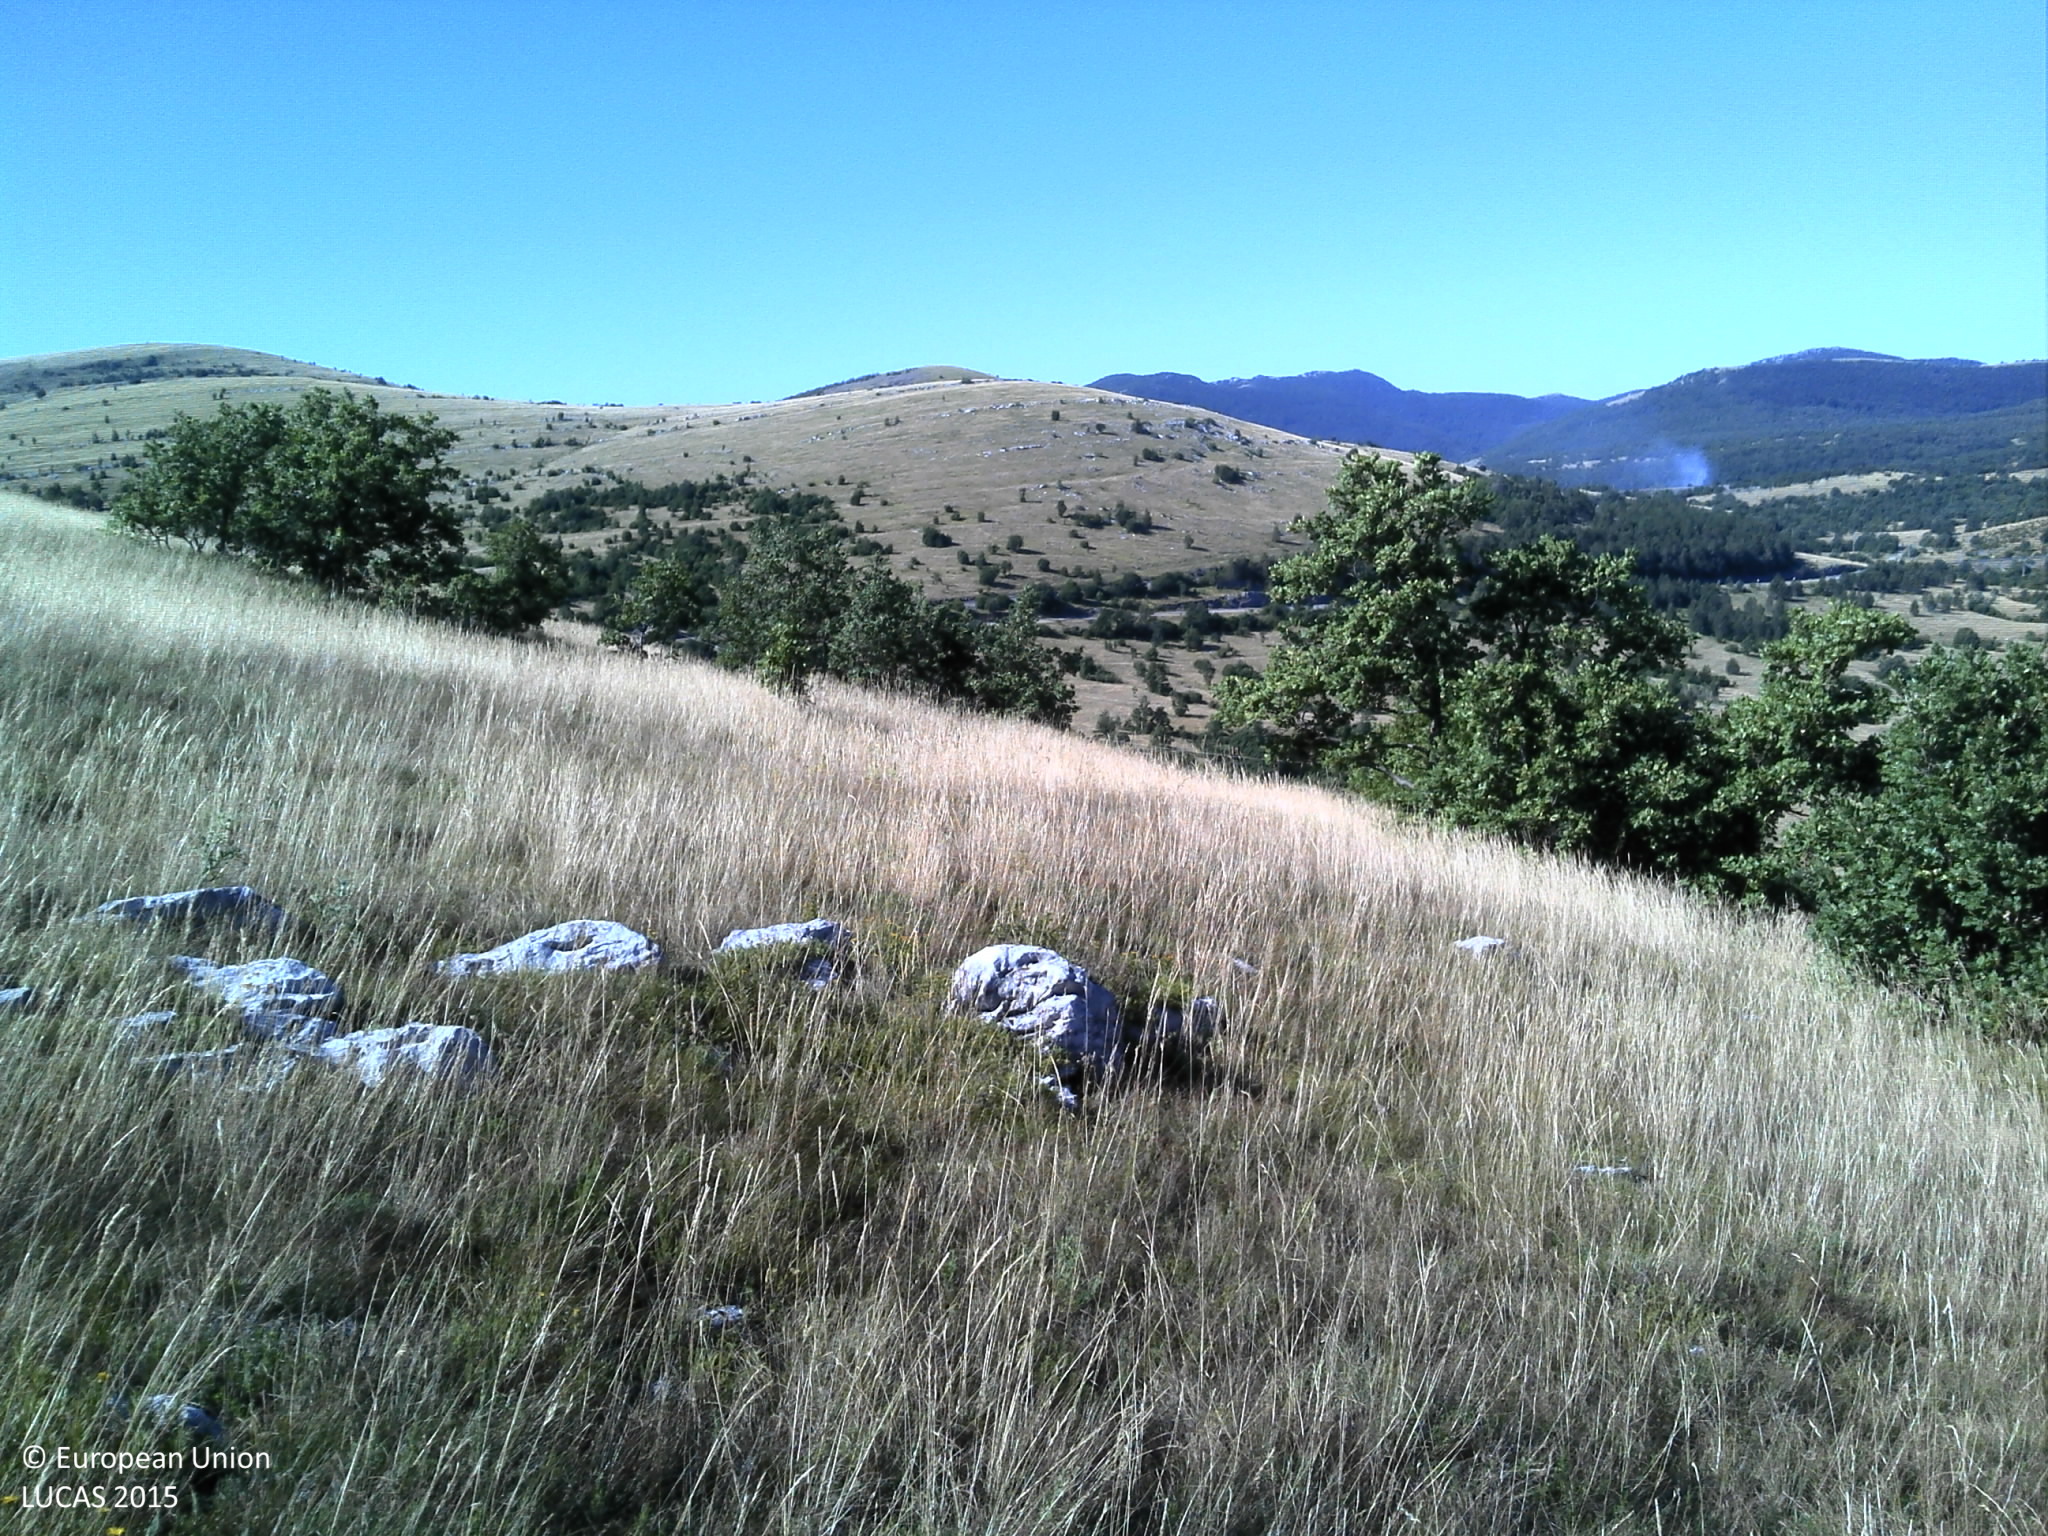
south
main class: Grassland
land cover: Grassland with sparse tree/shrub cover
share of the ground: > 75 %
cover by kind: herbaceous plants 80 %, broadleaved forest trees 5 %, shrubs 5 %, consolidated bare surface 5 %, unconsolidated bare surface 5 %
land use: Semi-natural and natural areas not in use
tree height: < 5 m
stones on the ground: 10 - 25 %
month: July
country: HR
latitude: 44.2648
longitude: 16.0435
